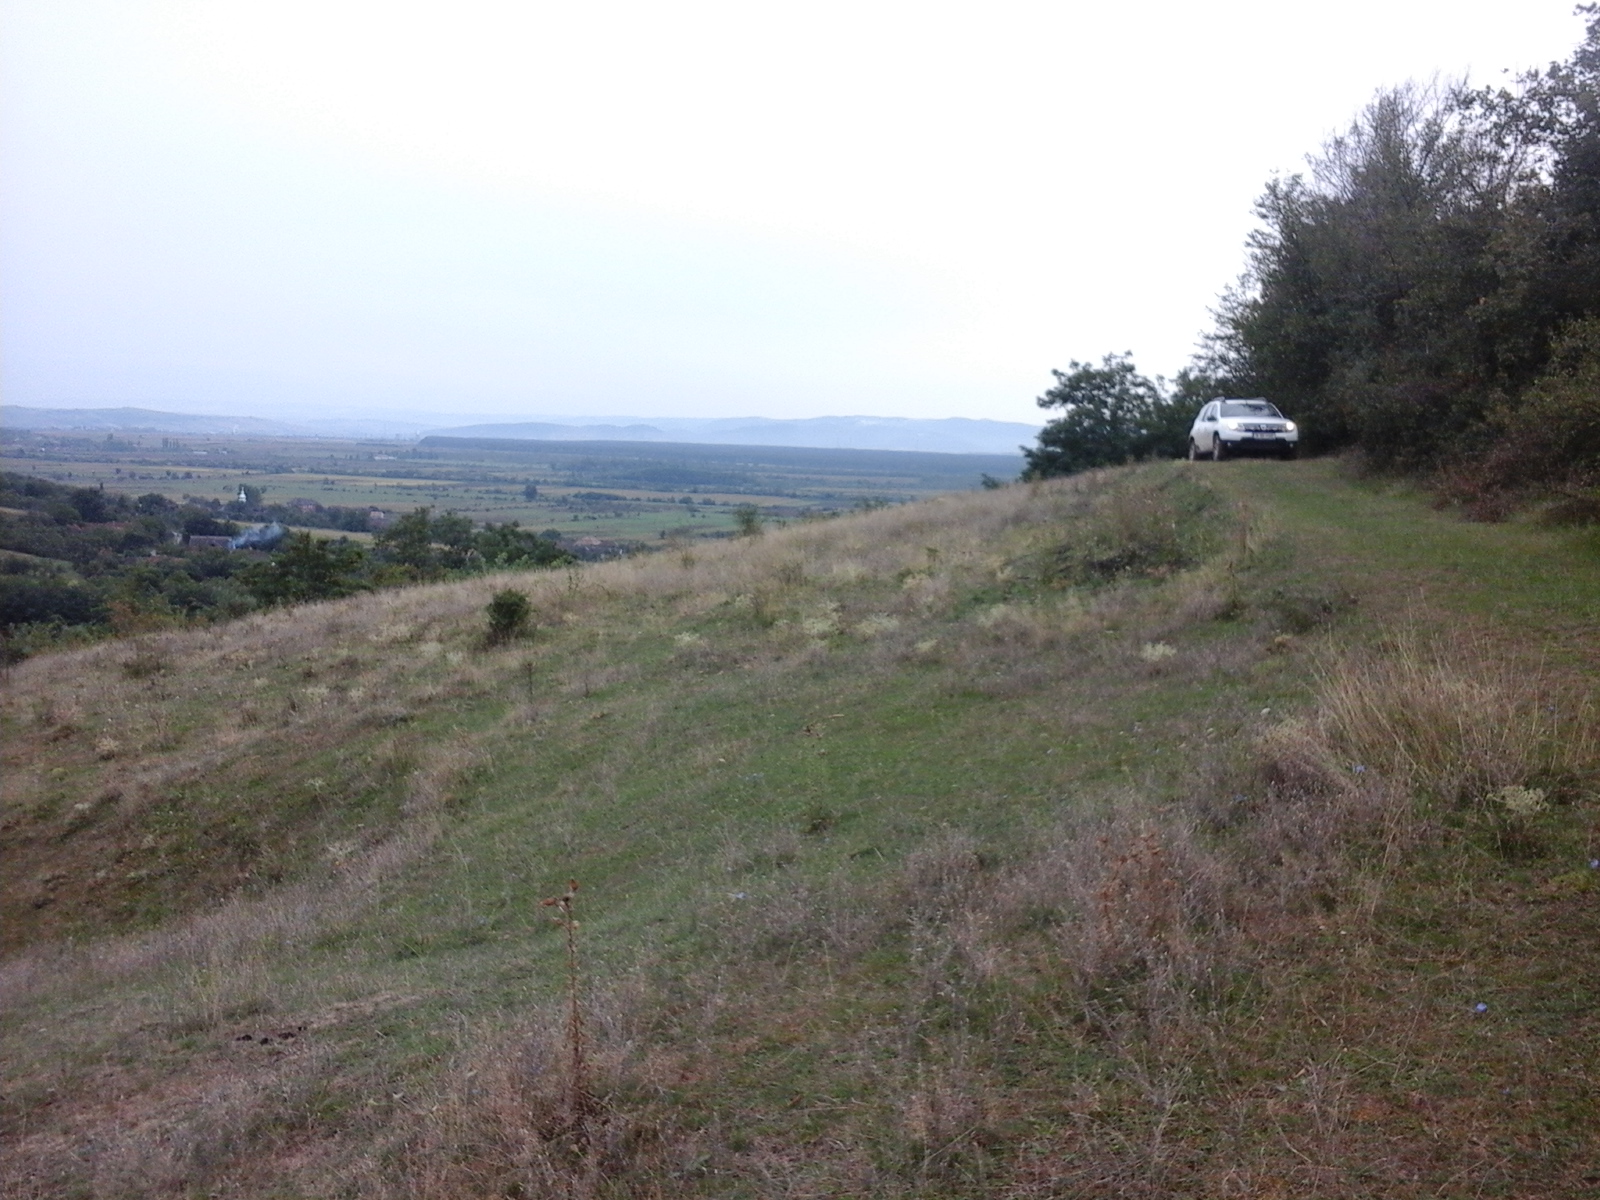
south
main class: Grassland
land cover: Grassland with sparse tree/shrub cover
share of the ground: > 75 %
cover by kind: herbaceous plants 85 %, shrubs 10 %, broadleaved forest trees 5 %
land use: Agriculture (excluding fallow land and kitchen gardens)
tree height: < 5 m
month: September
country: RO
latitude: 47.3259
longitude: 22.5071
